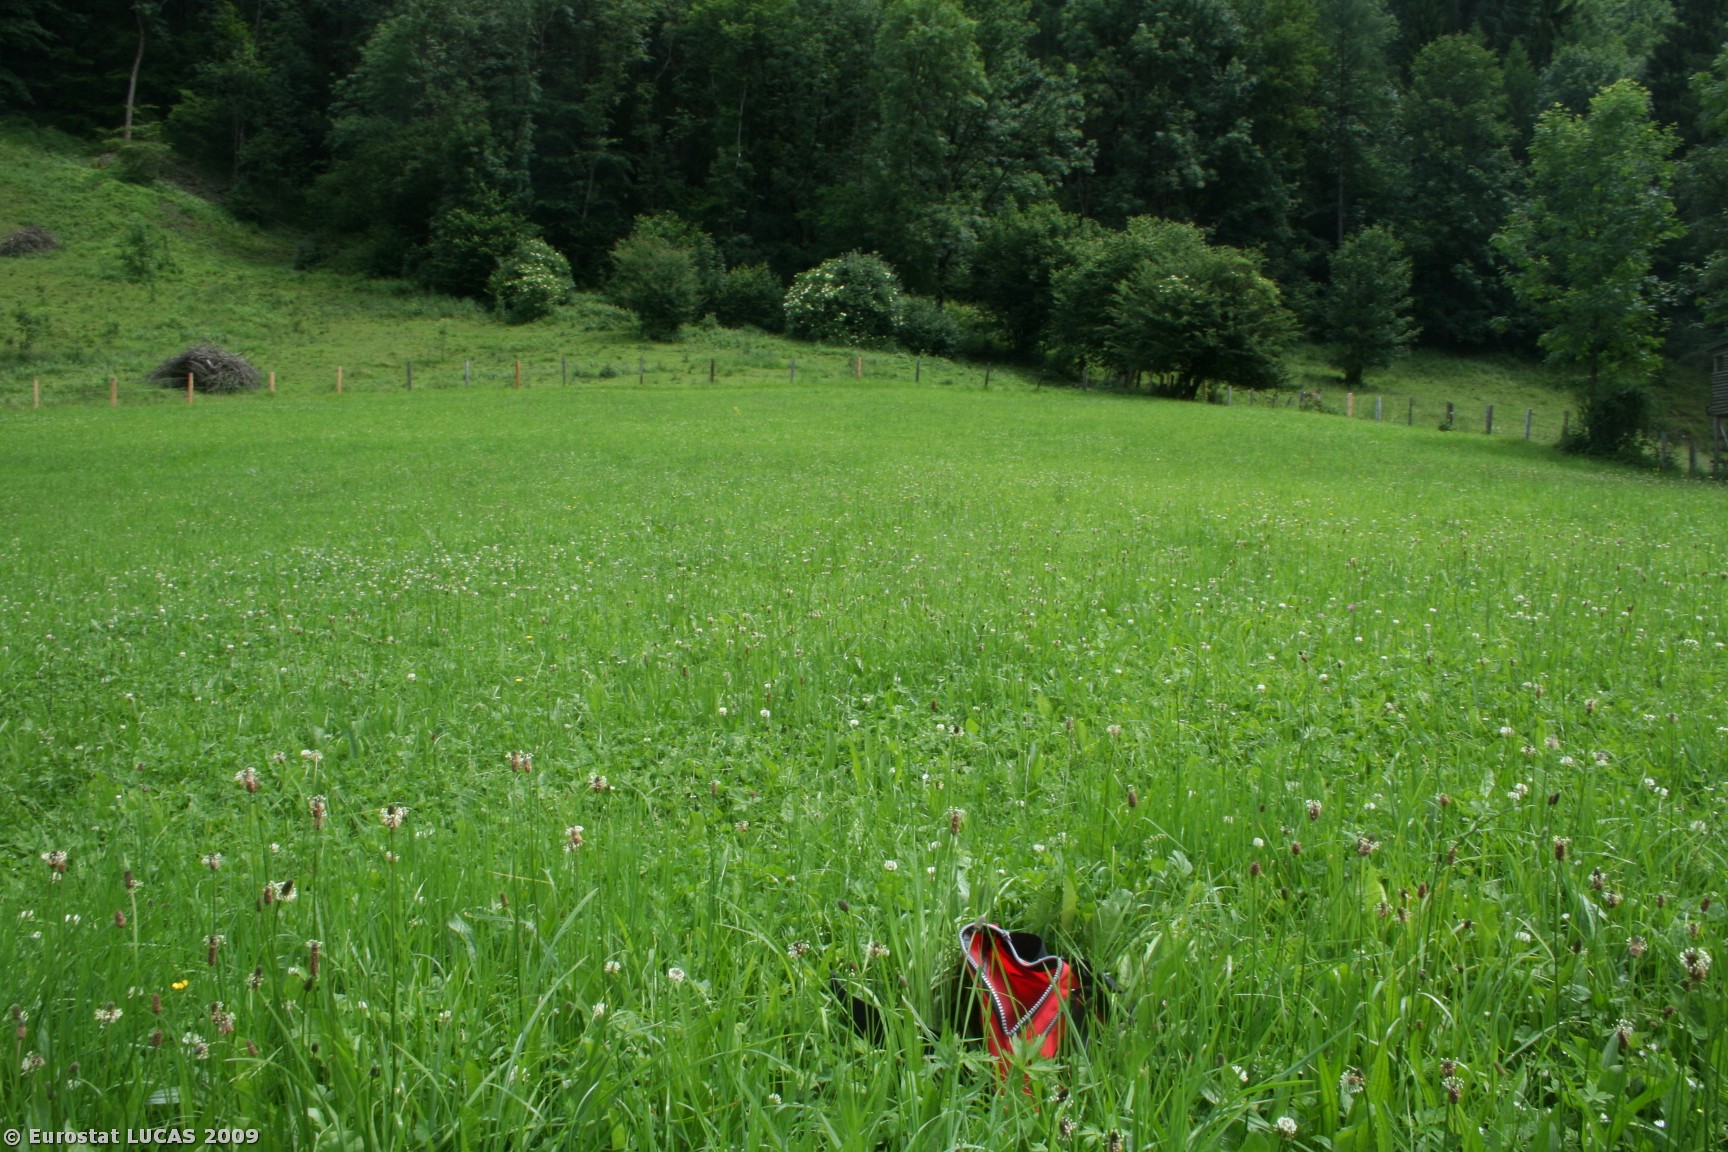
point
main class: Grassland
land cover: Grassland without tree/shrub cover
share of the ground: > 75 %
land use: Agriculture (excluding fallow land and kitchen gardens)
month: June
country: AT
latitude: 47.3661
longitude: 13.2159
